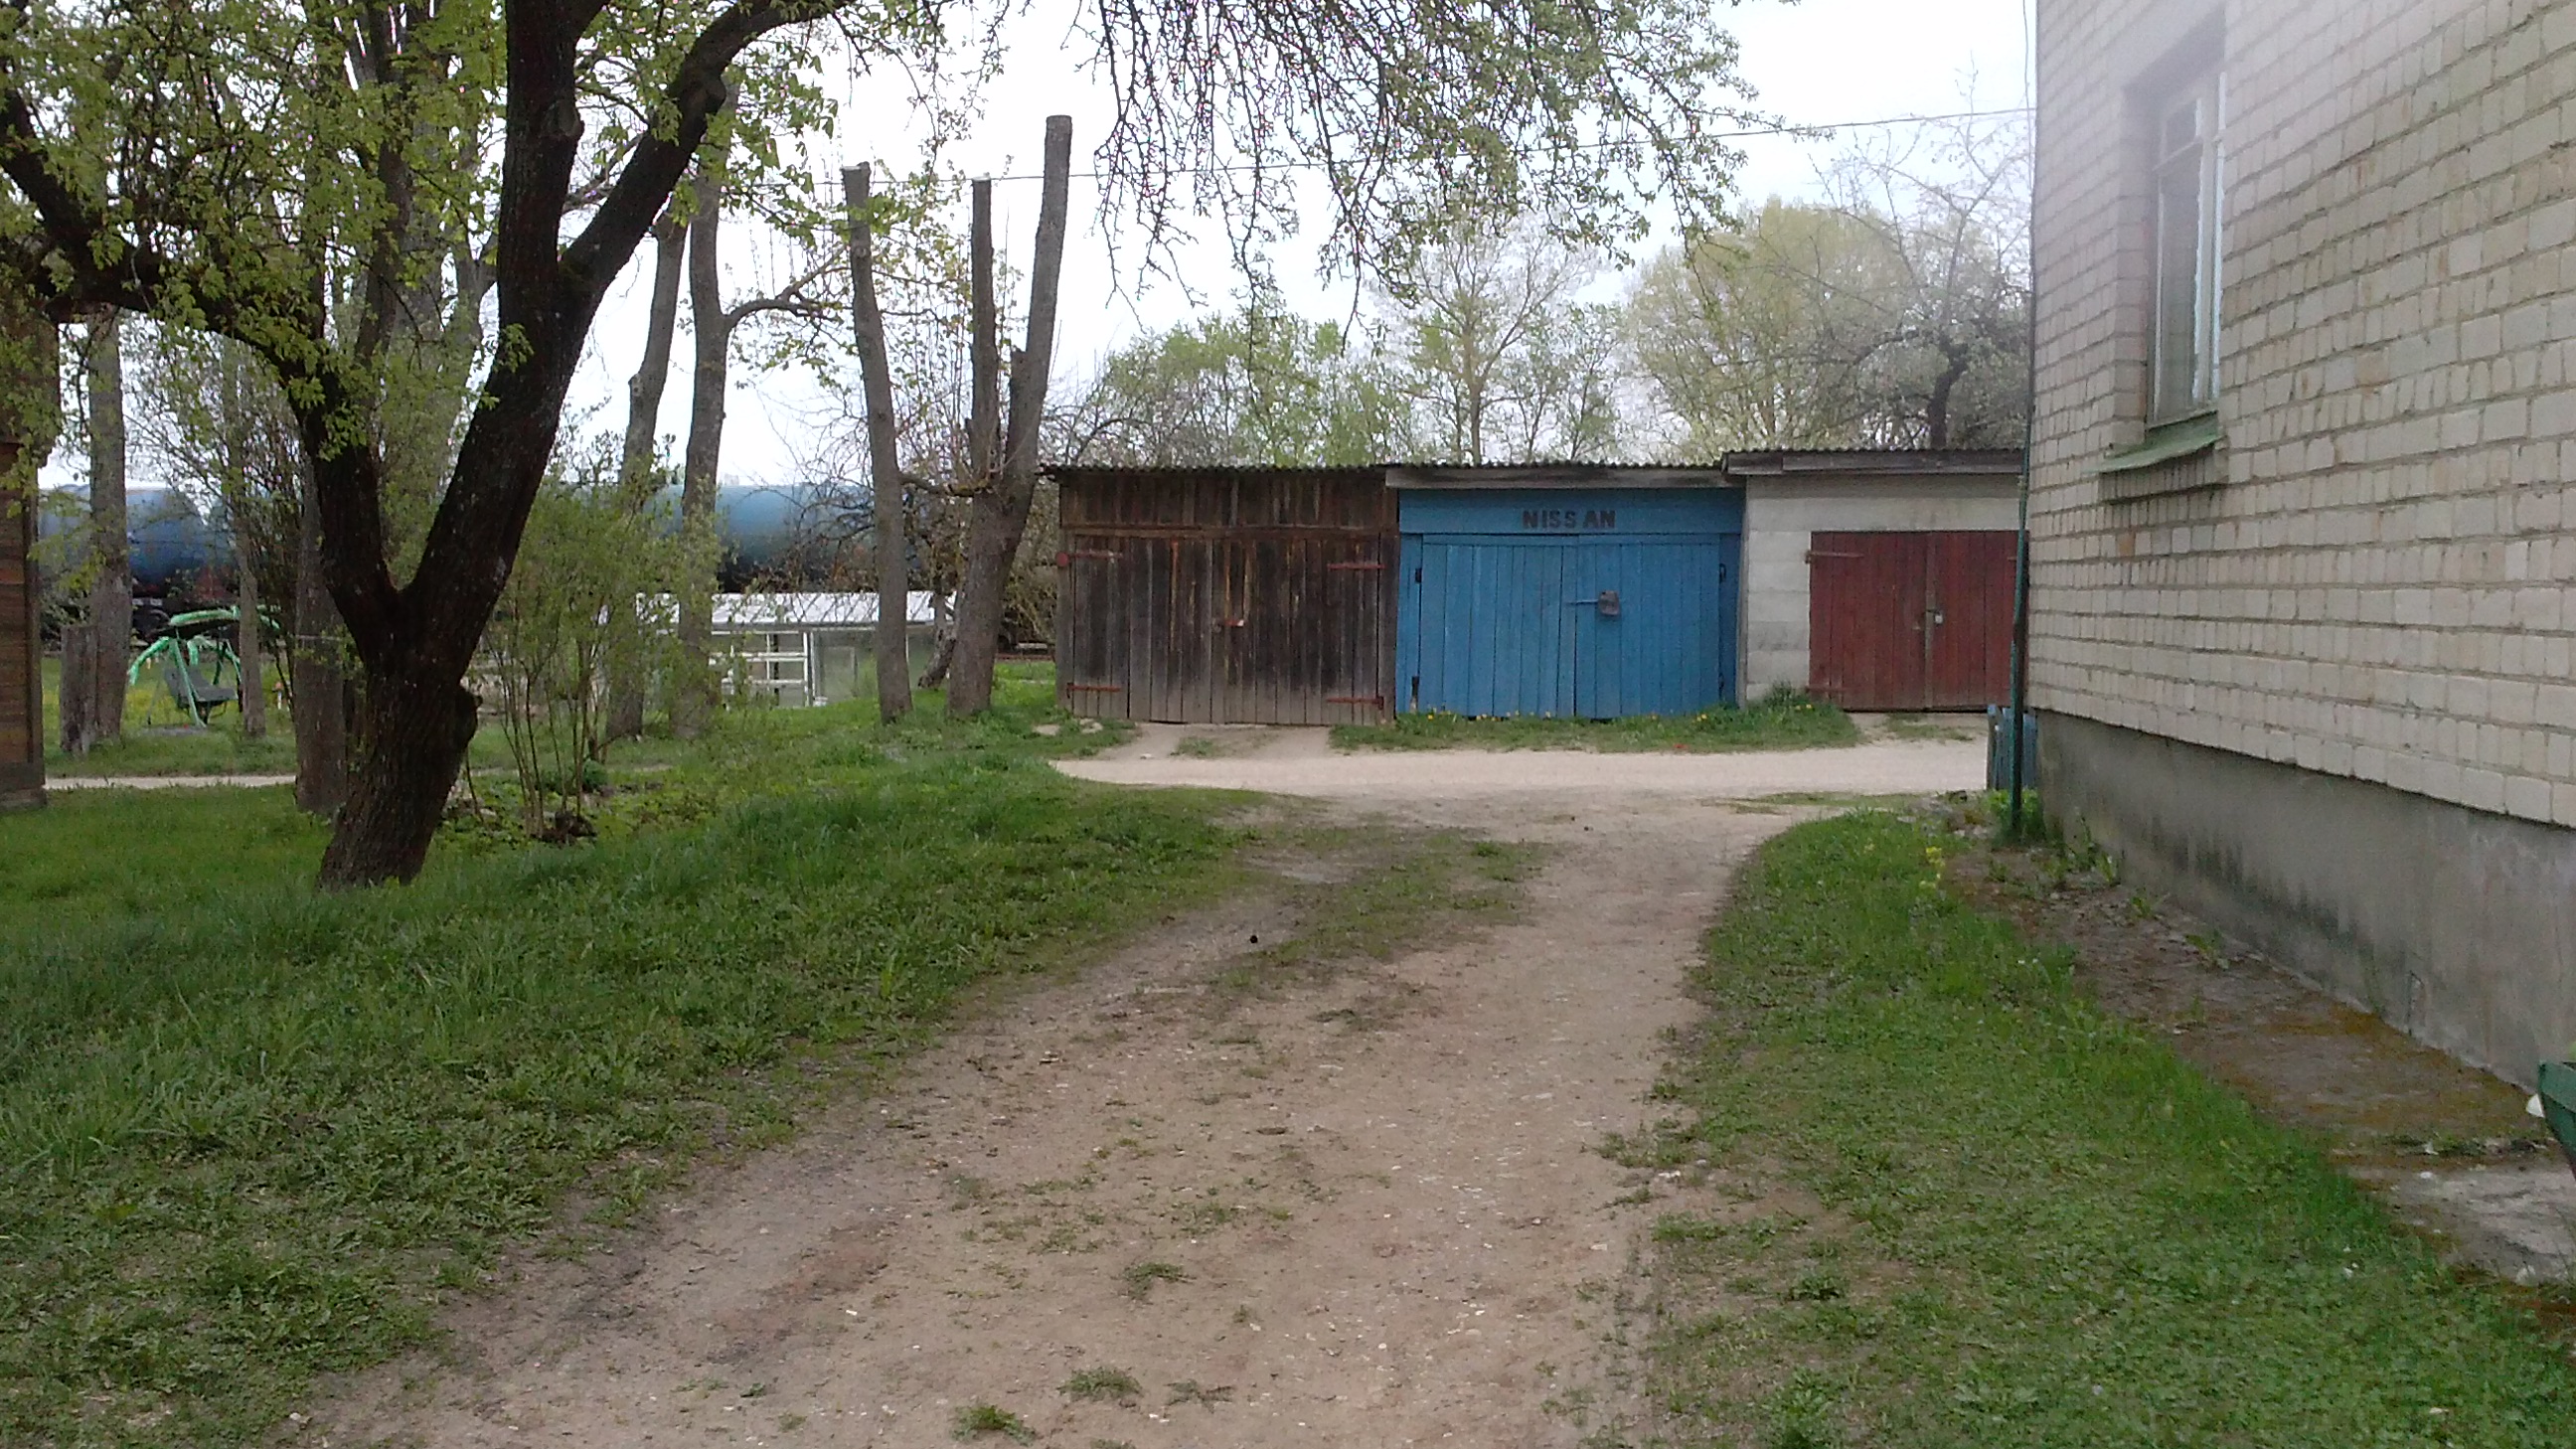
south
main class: Cropland
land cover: Floriculture and ornamental plants
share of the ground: > 75 %
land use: Kitchen garden
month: May
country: LV
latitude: 55.9231
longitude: 27.1496
